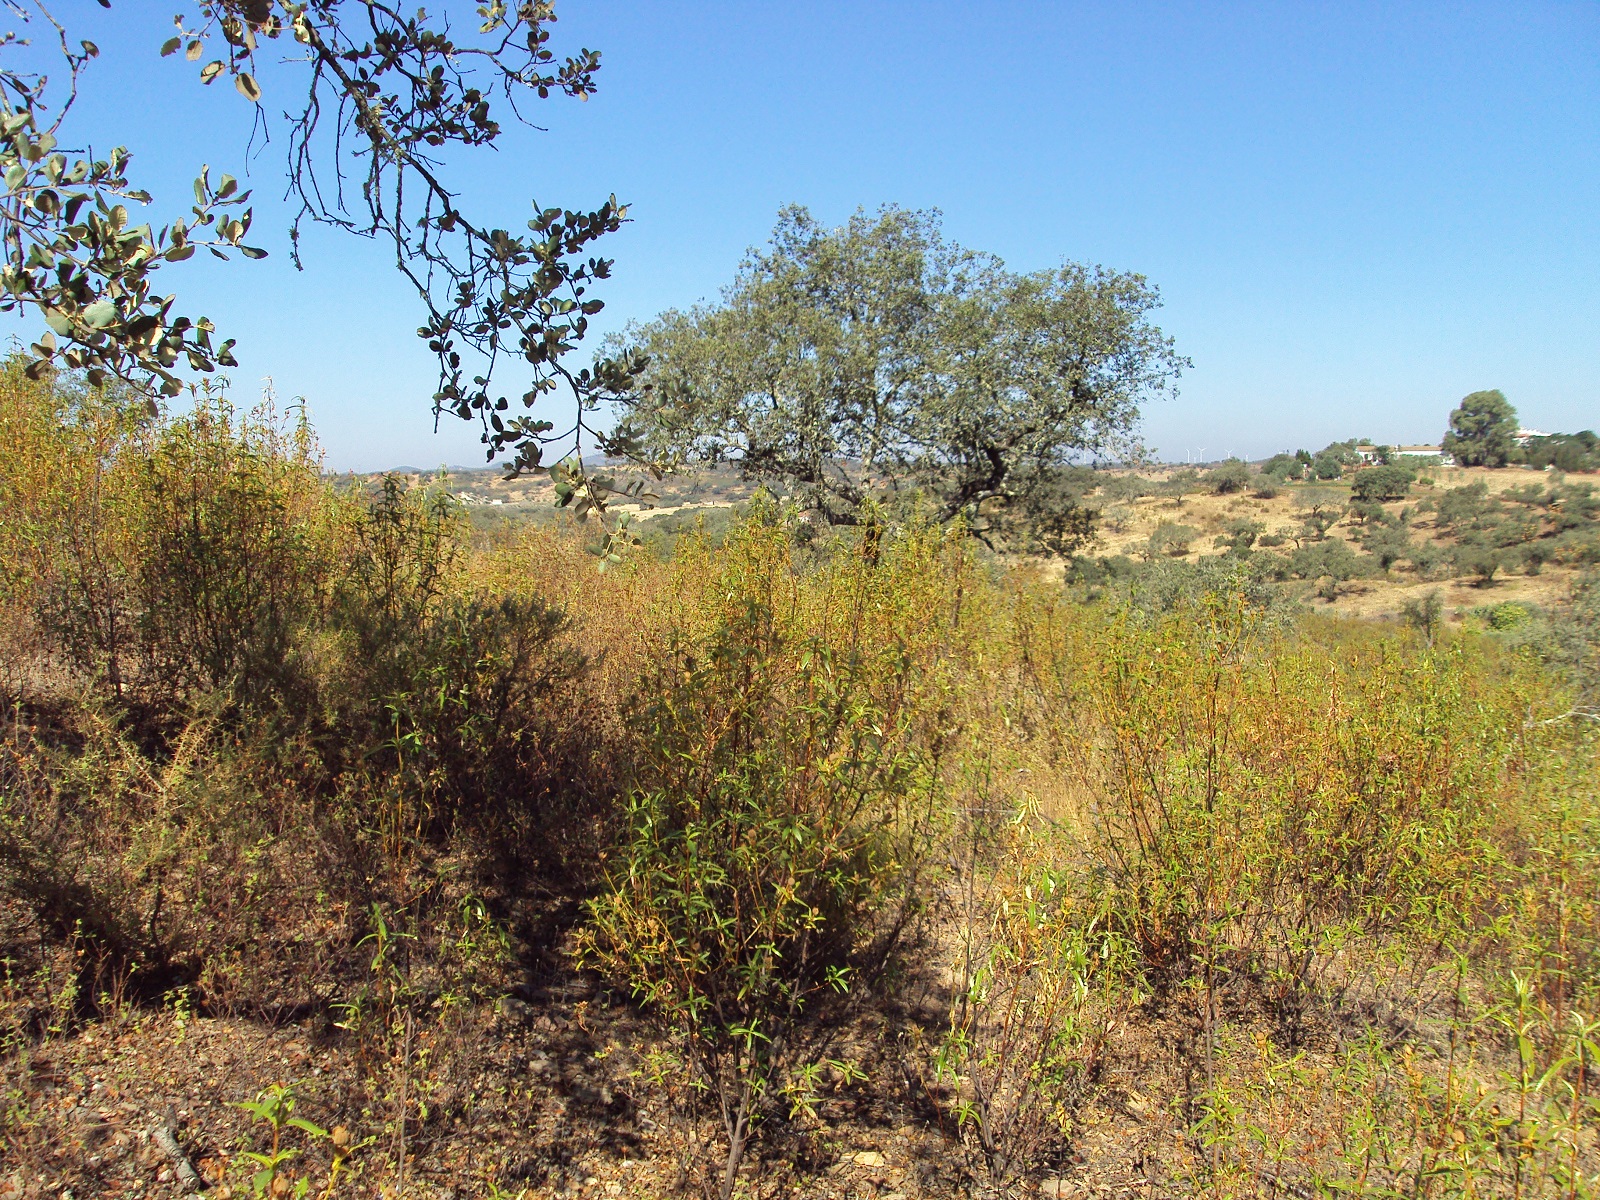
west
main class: Woodland
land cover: Broadleaved woodland
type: broadleaved evergreen forest
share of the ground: 50 - 75 %
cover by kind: broadleaved forest trees 50 %, shrubs 40 %, herbaceous plants 10 %
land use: Agriculture (excluding fallow land and kitchen gardens)
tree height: > 5 m
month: June
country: ES
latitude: 37.5309
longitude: -7.1234
